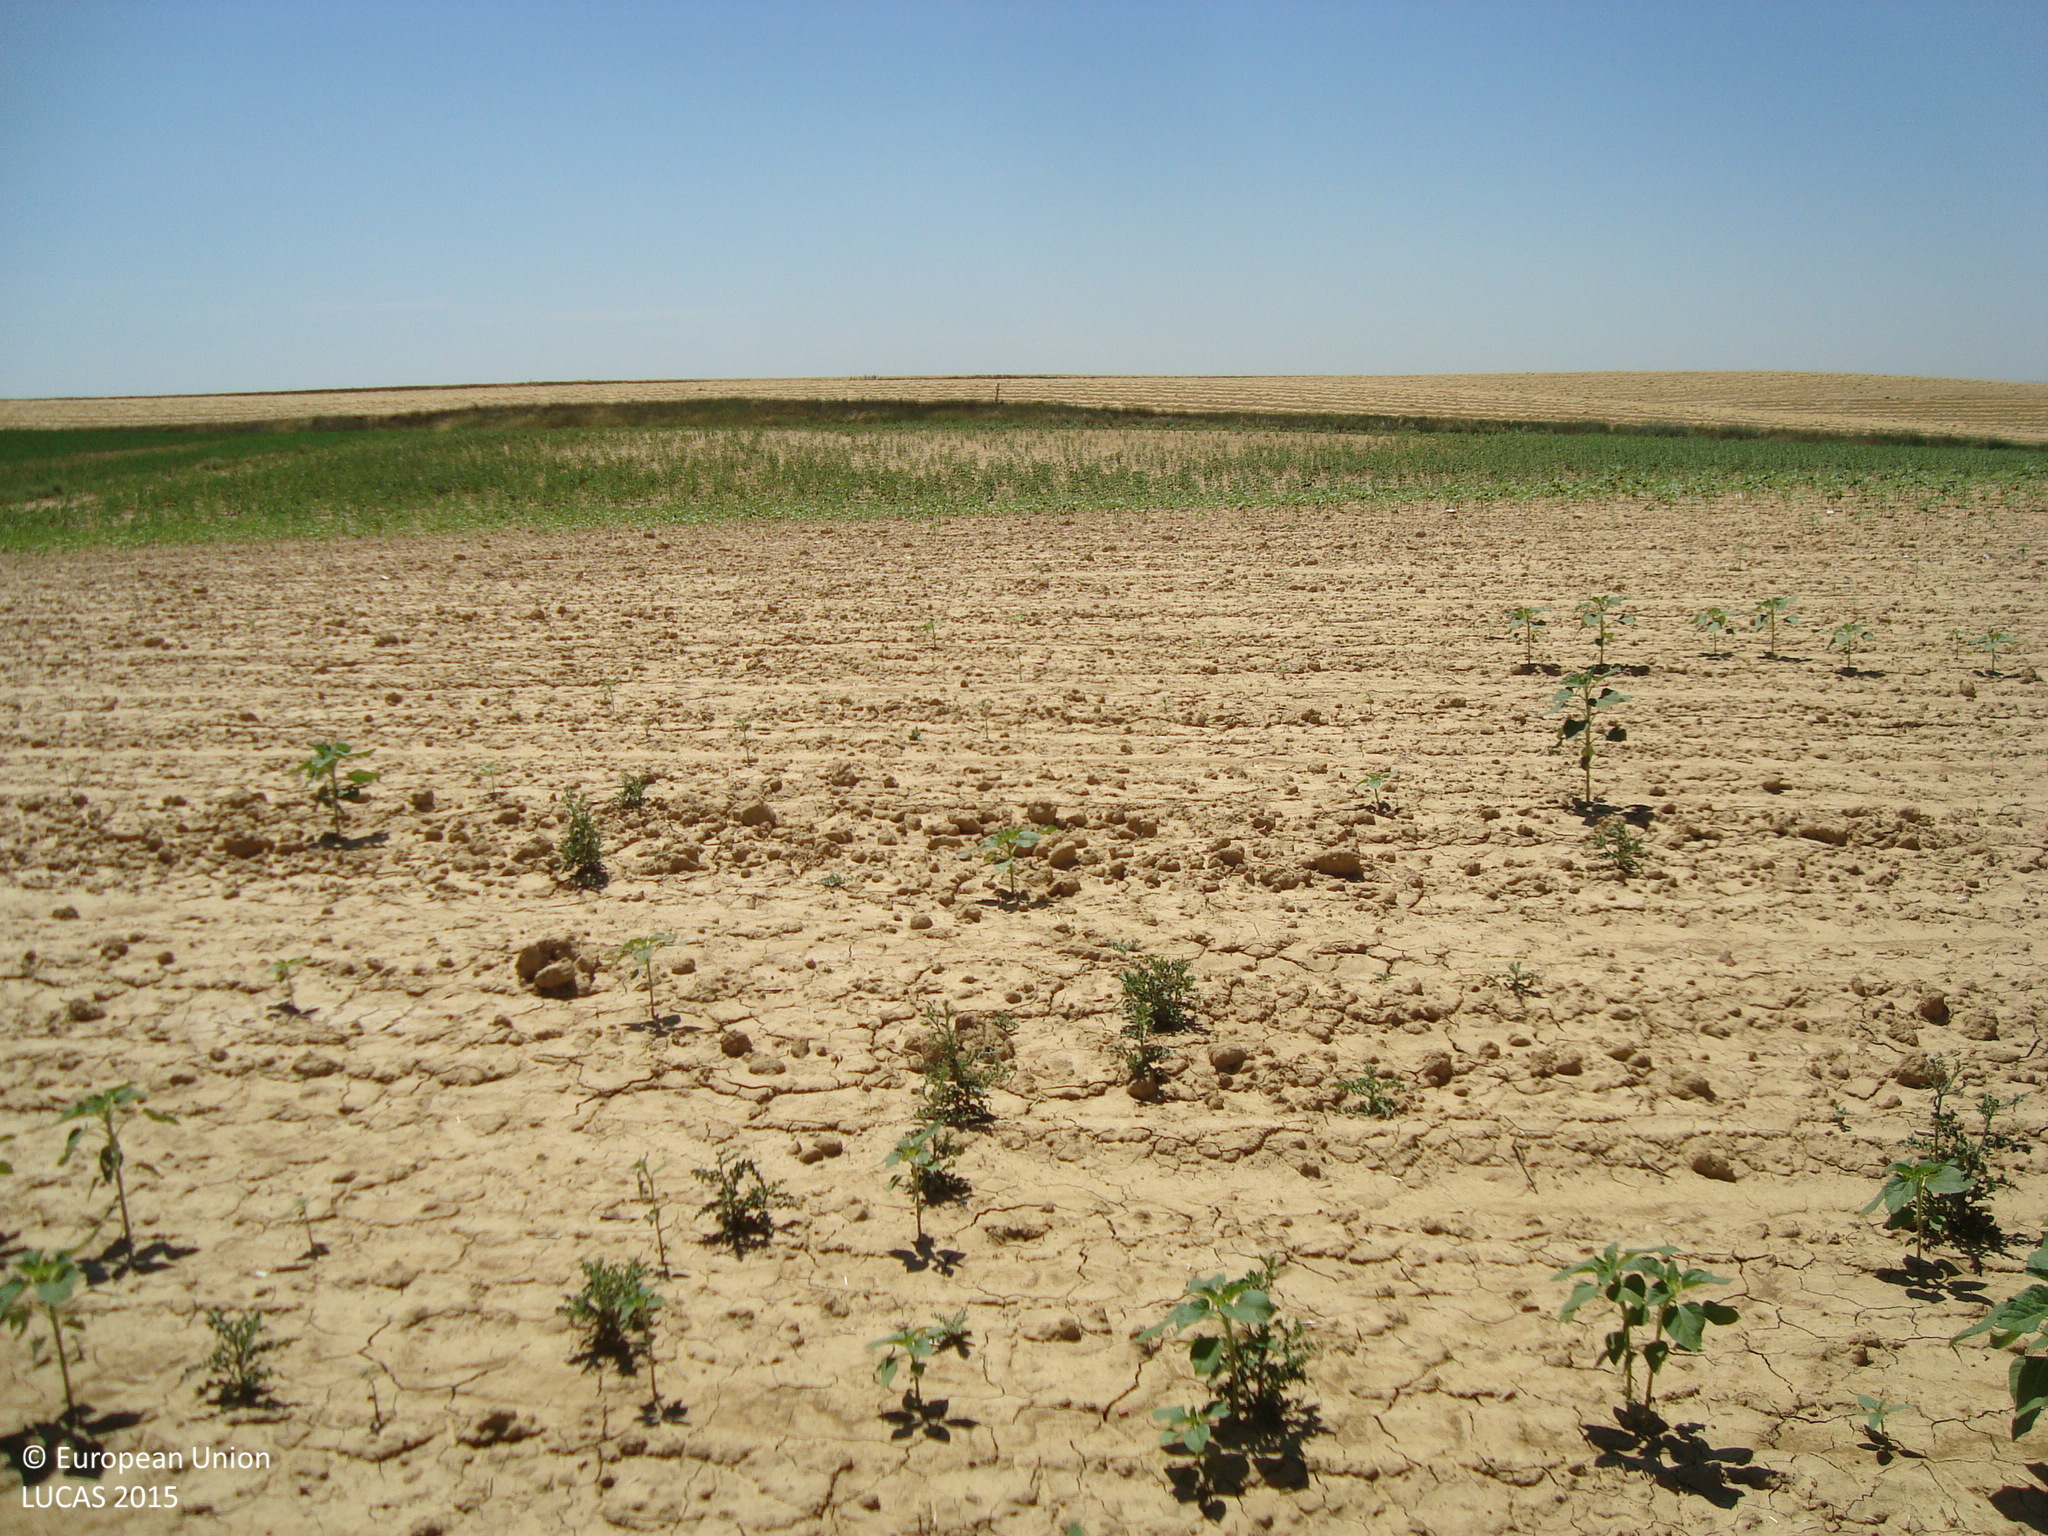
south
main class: Cropland
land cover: Sunflower
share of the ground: 25 - 50 %
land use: Agriculture (excluding fallow land and kitchen gardens)
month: July
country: ES
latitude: 42.1424
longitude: -4.8267
